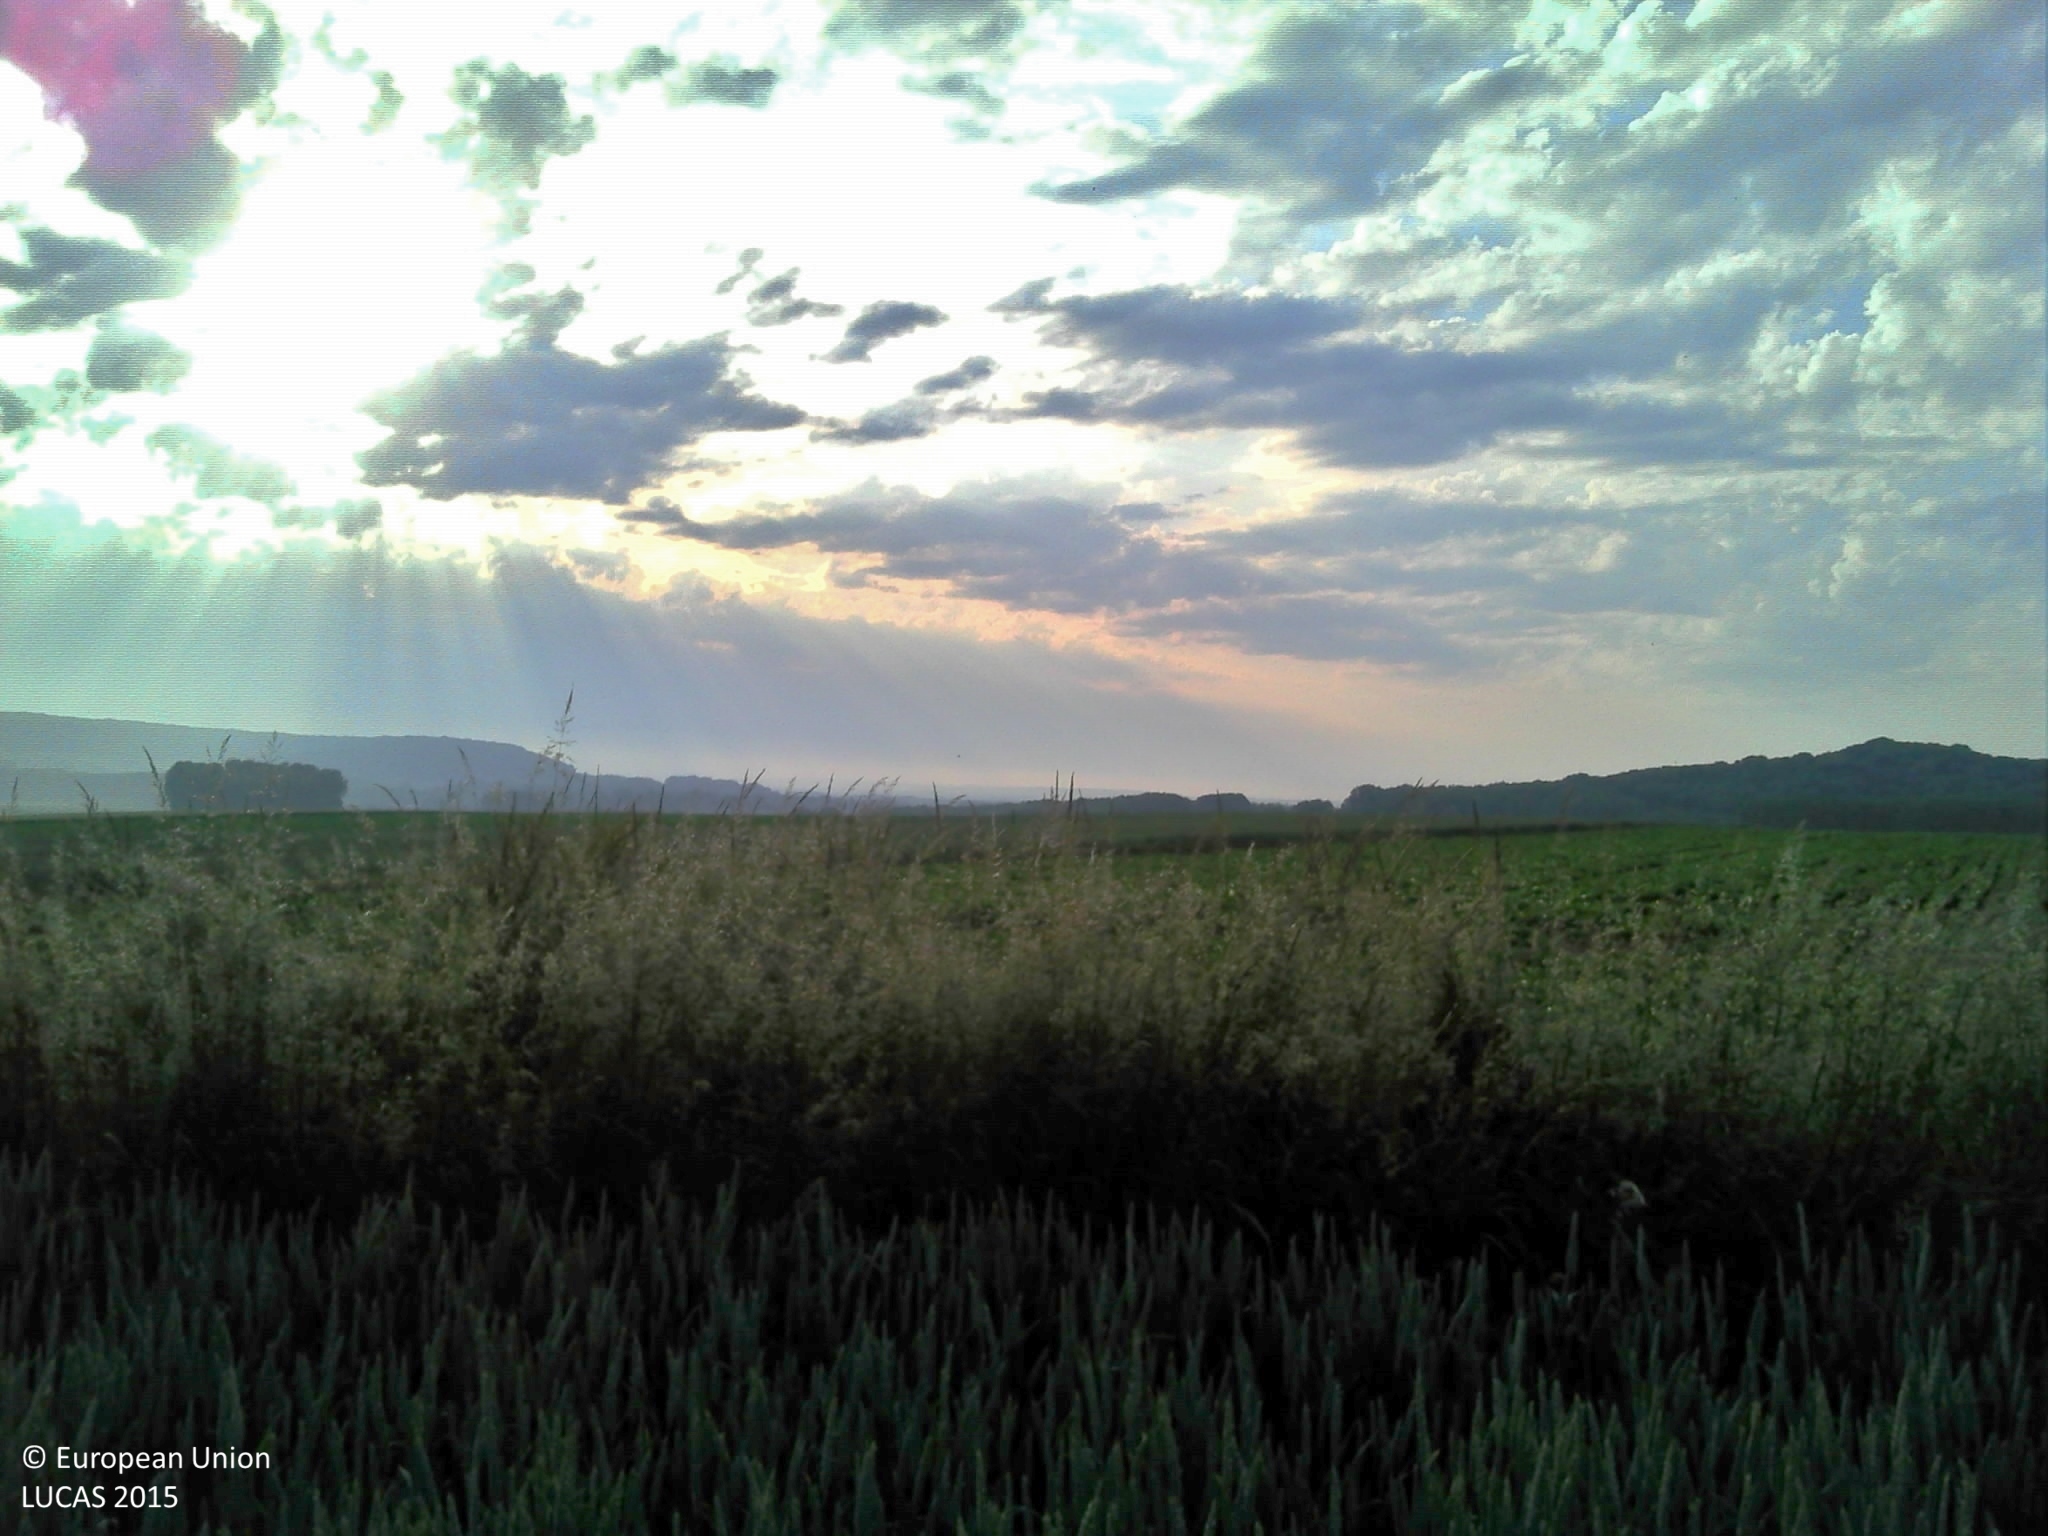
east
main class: Cropland
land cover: Common wheat
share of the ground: > 75 %
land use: Agriculture (excluding fallow land and kitchen gardens)
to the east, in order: Common wheat; Shruby margins; Sugar beet; Grass margins; Common wheat; Sugar beet
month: June
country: FR
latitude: 49.4886
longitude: 2.8250
